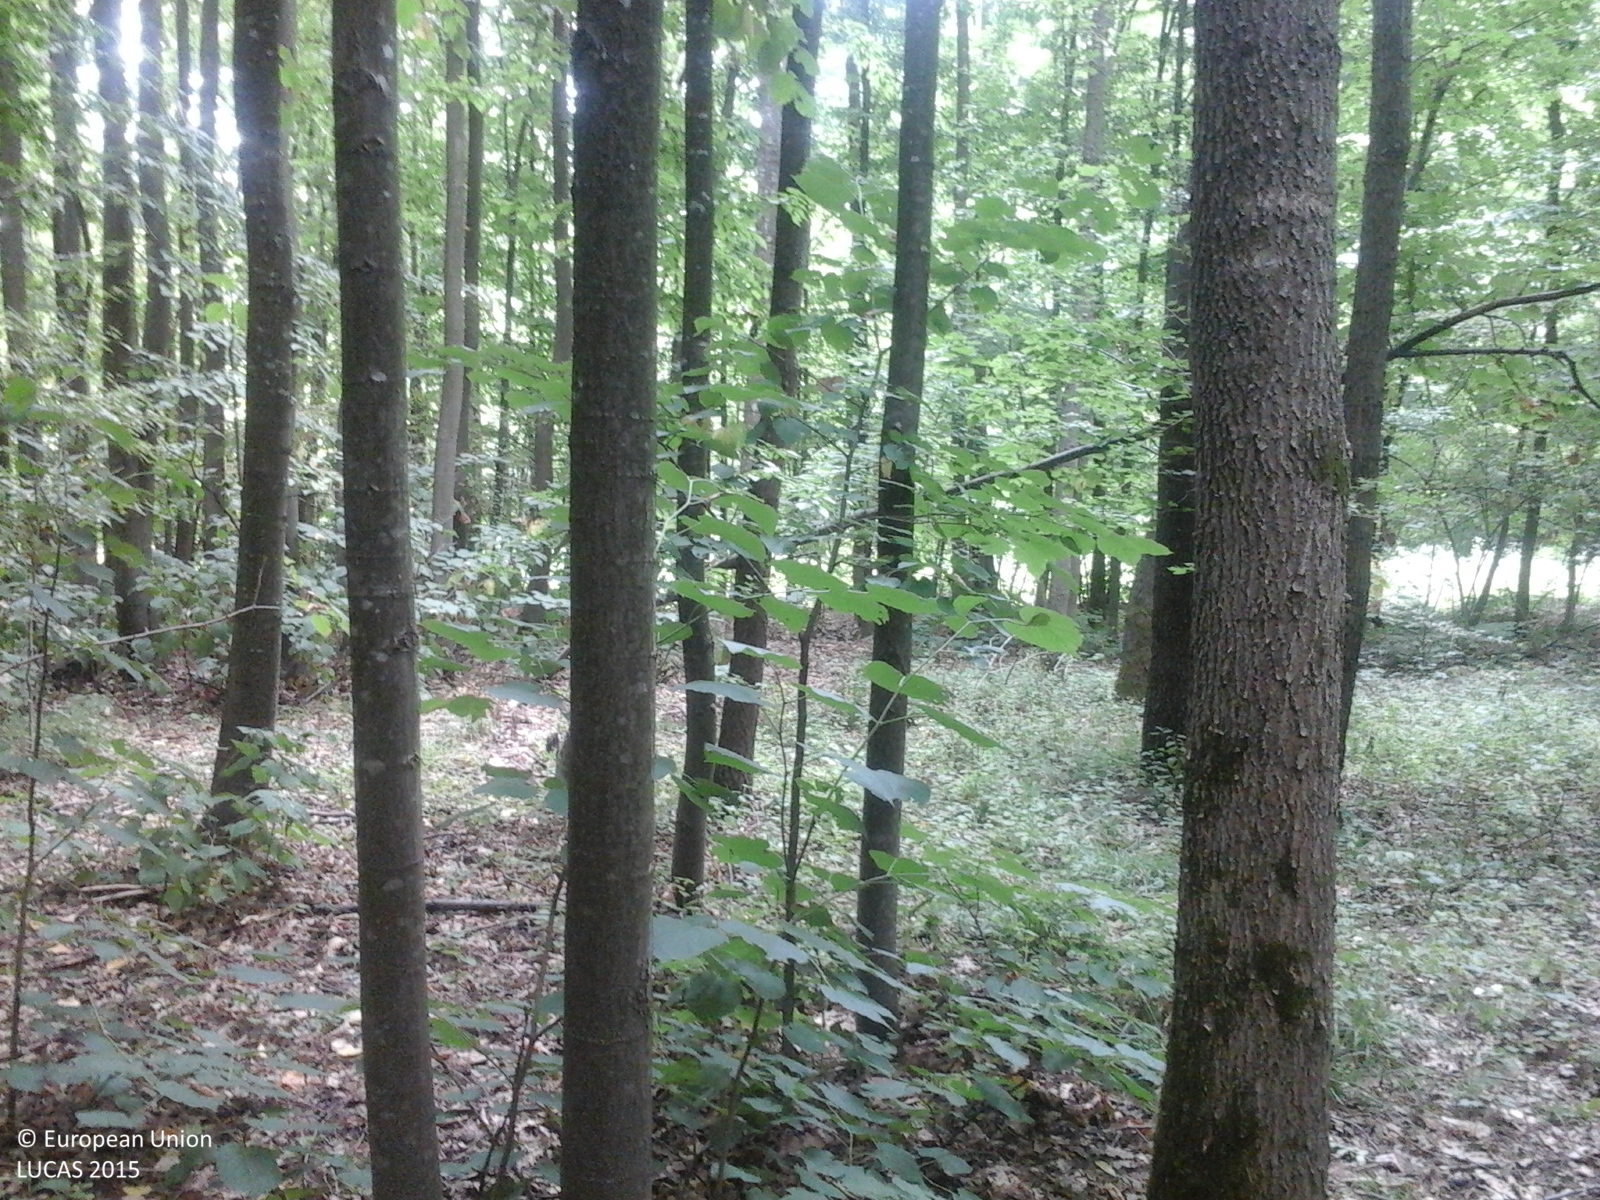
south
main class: Woodland
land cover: Broadleaved woodland
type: mesophytic deciduous forest
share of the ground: > 75 %
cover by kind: broadleaved forest trees 100 %
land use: Forestry
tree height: > 5 m
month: July
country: RO
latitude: 44.4756
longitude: 25.6461
